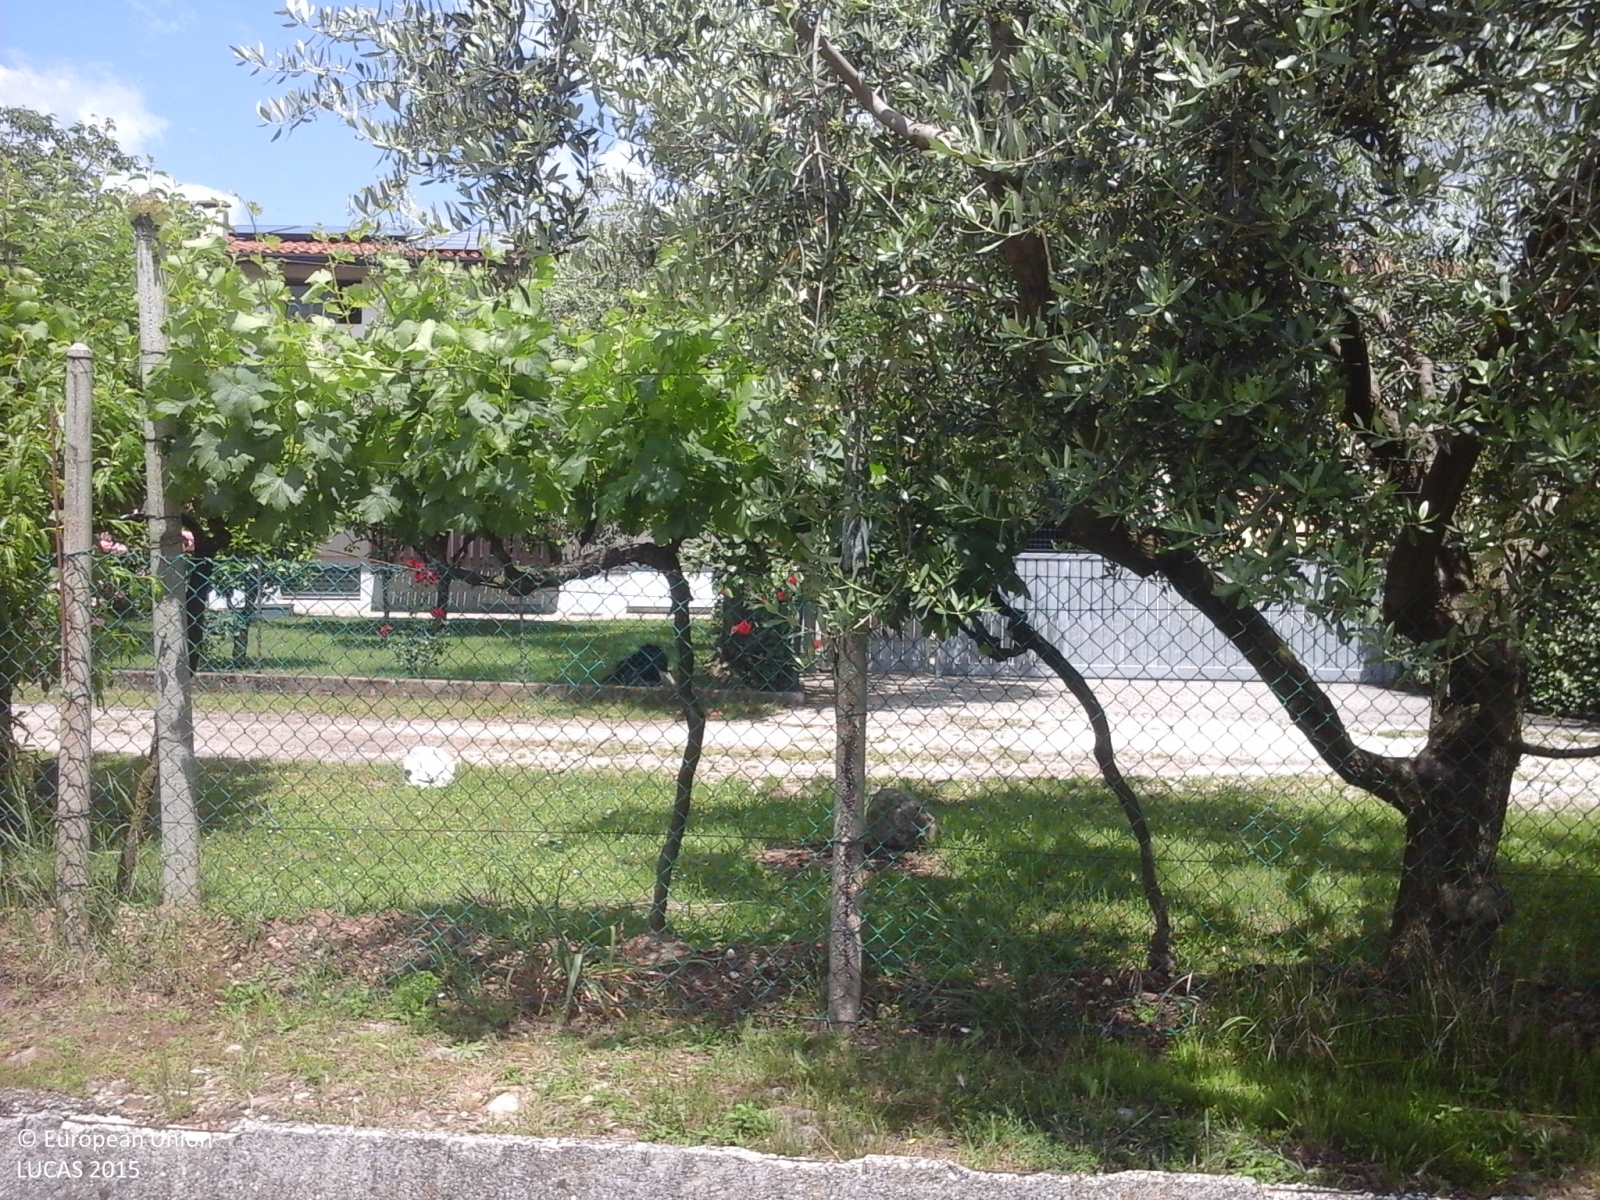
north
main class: Cropland
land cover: Barley
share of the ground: > 75 %
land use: Agriculture (excluding fallow land and kitchen gardens)
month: May
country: IT
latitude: 45.7425
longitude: 11.7325
